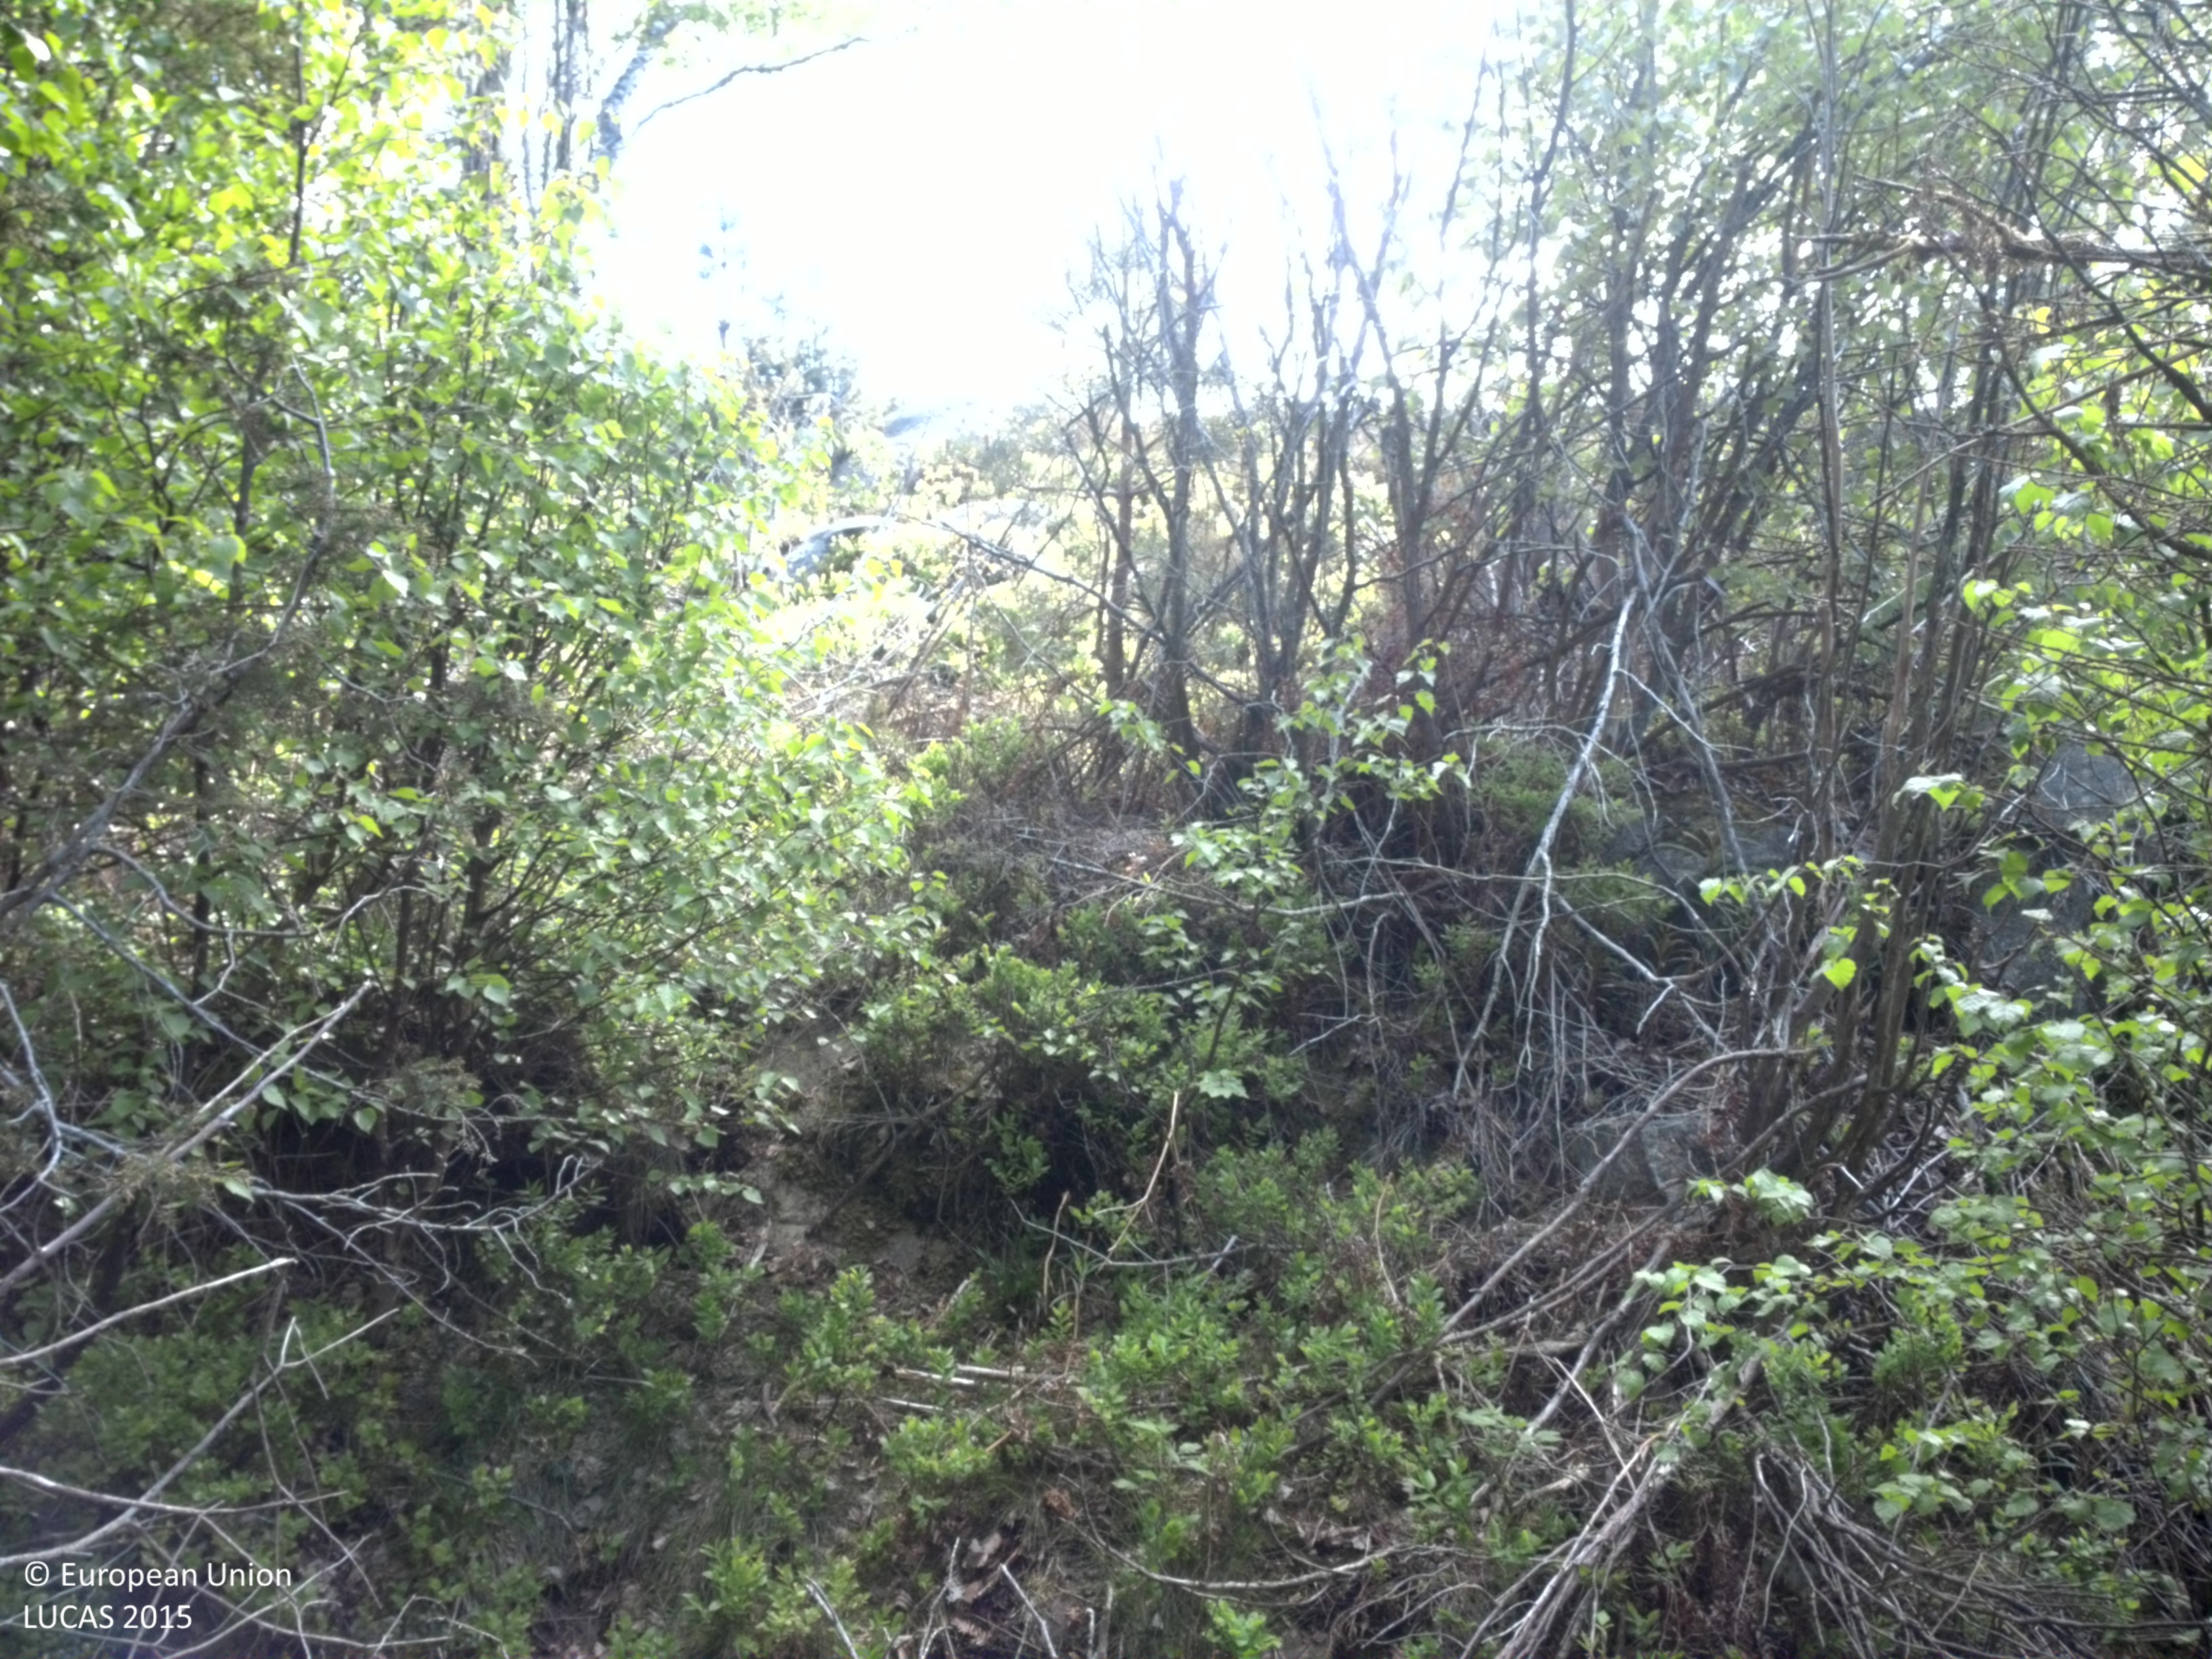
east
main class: Woodland
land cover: Pine dominated mixed woodland
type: boreal forest
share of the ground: 50 - 75 %
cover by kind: coniferous forest trees 50 %, broadleaved forest trees 25 %, shrubs 15 %, herbaceous plants 10 %
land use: Amenities, museums, leisure
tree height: > 5 m
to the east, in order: Pine dominated mixed woodland; Shrubland with sparse tree cover; Pine dominated mixed woodland
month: May
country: SE
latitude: 57.6116
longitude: 11.9552
